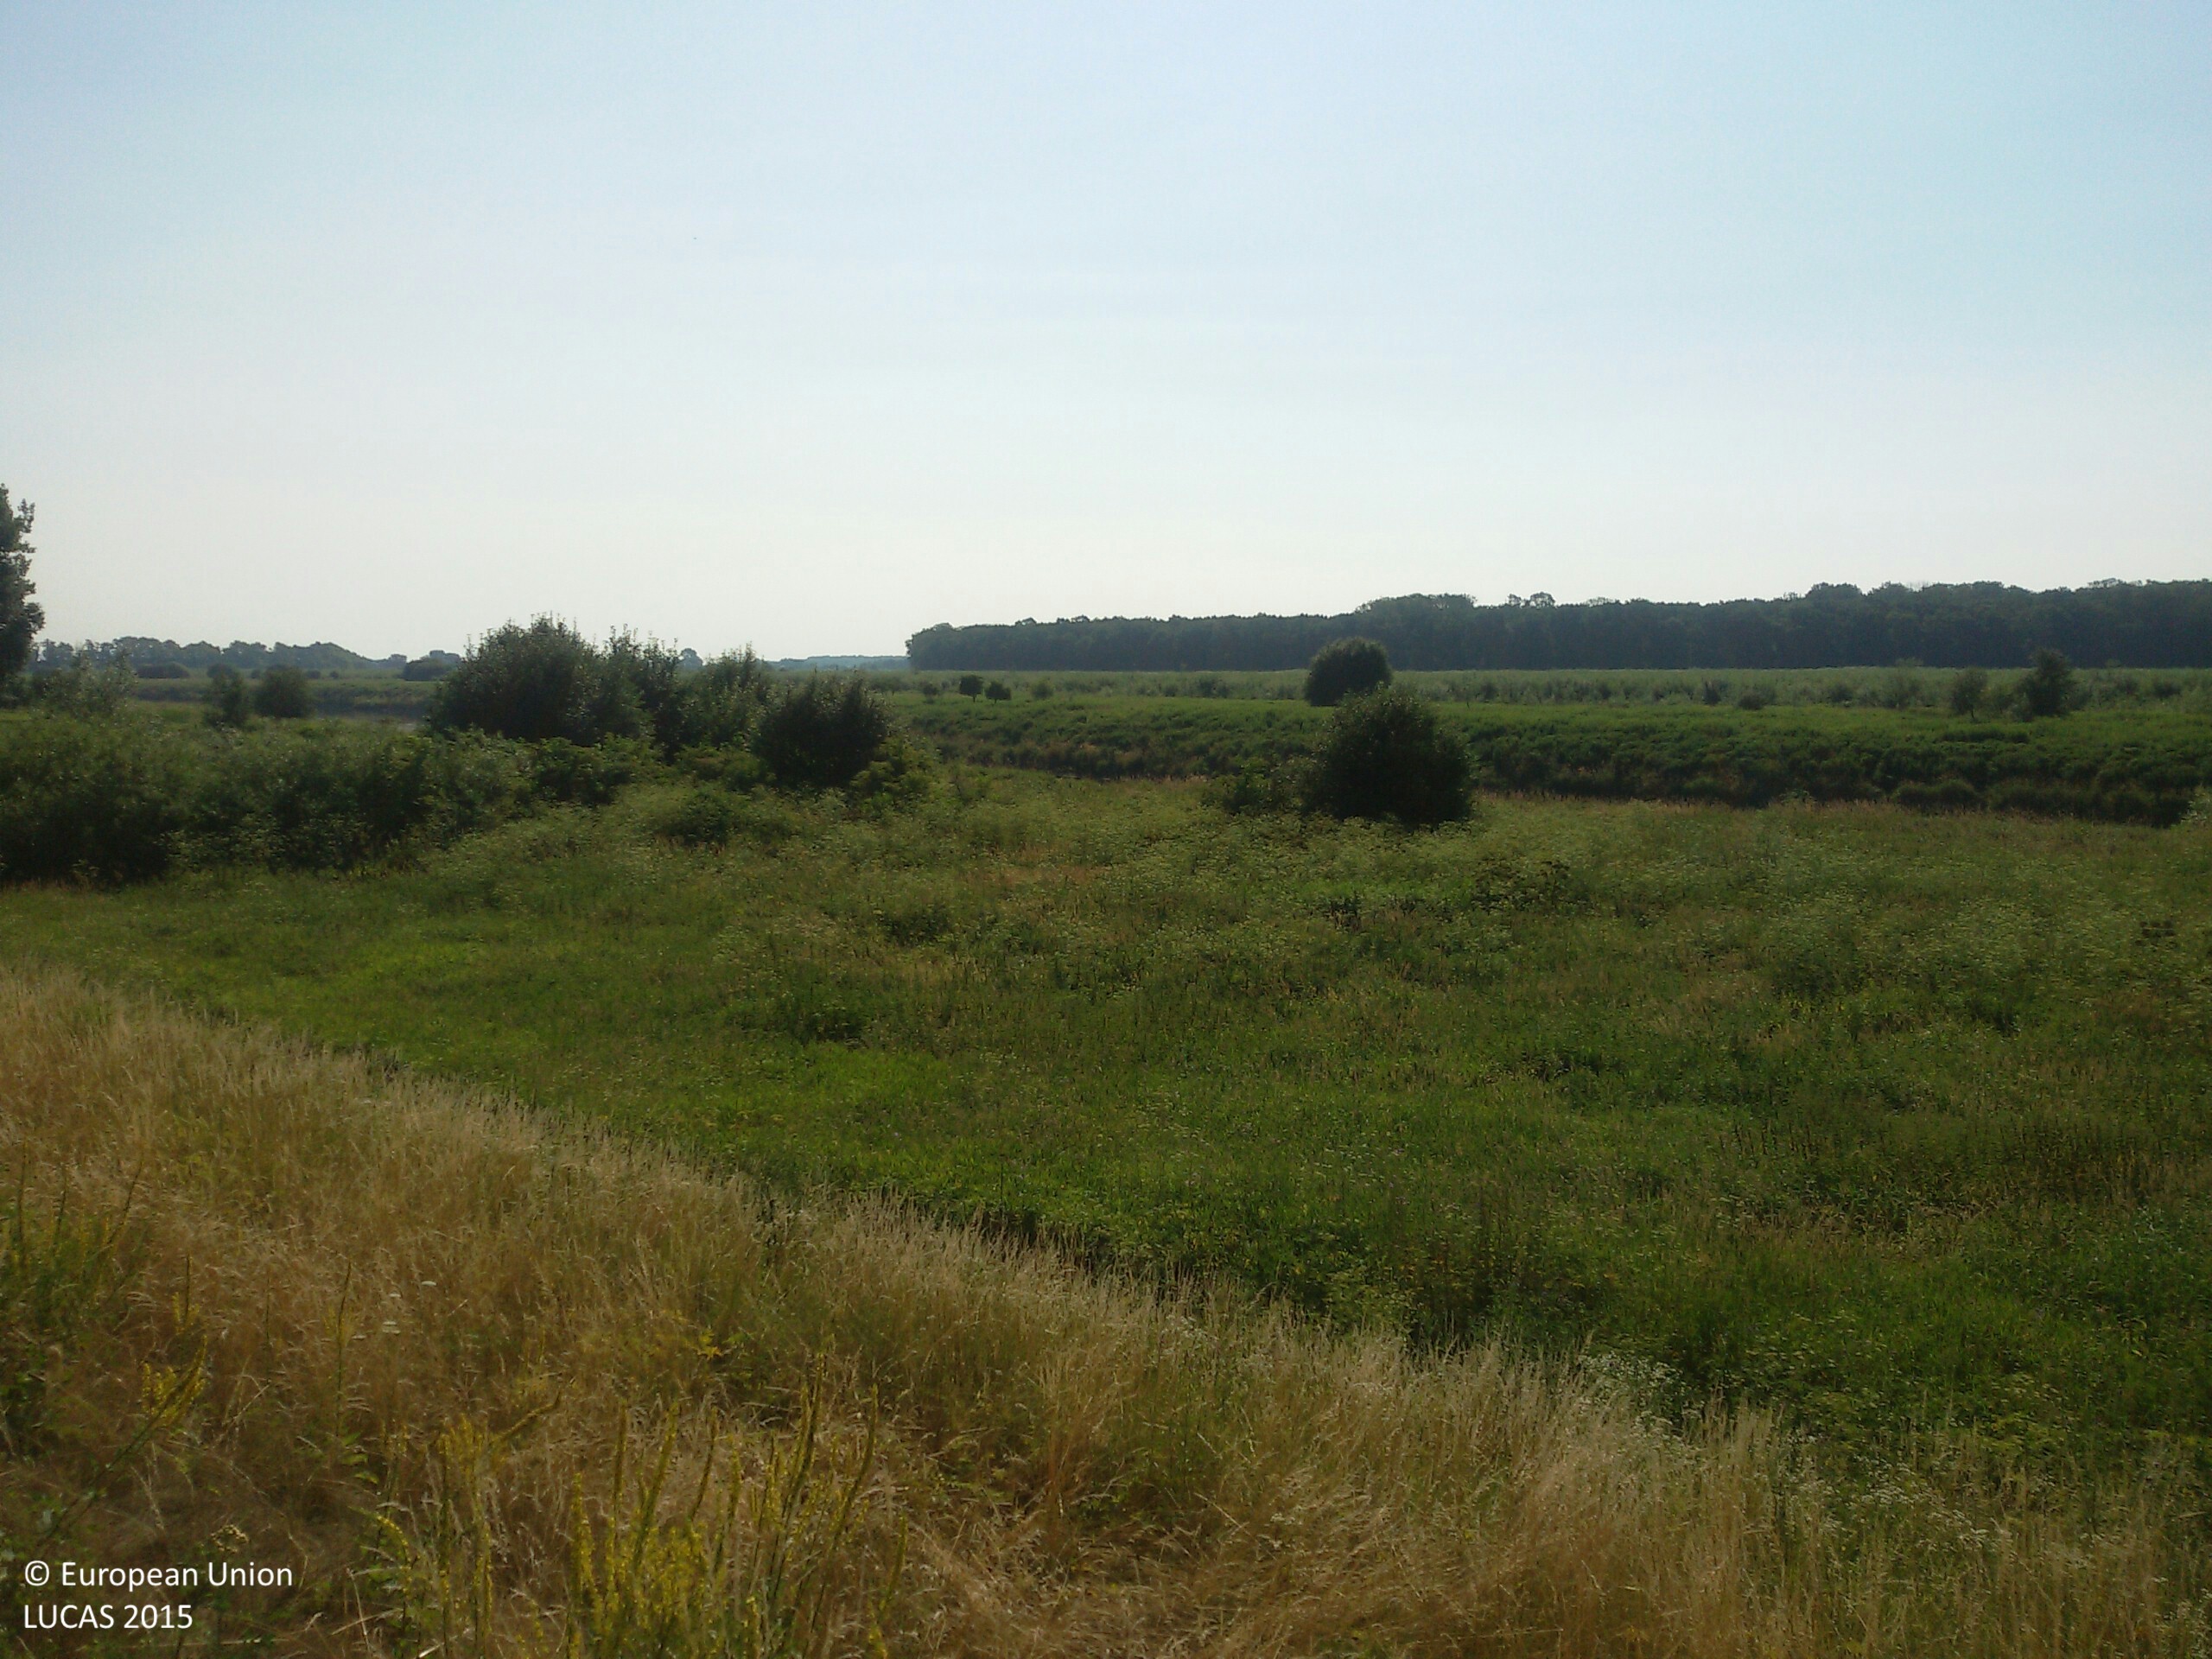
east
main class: Grassland
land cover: Spontaneously vegetated surfaces
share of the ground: > 75 %
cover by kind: herbaceous plants 100 %
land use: Semi-natural and natural areas not in use
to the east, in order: Spontaneously vegetated surfaces; Shrubland without tree cover
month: July
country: PL
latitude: 50.1116
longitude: 20.3418
